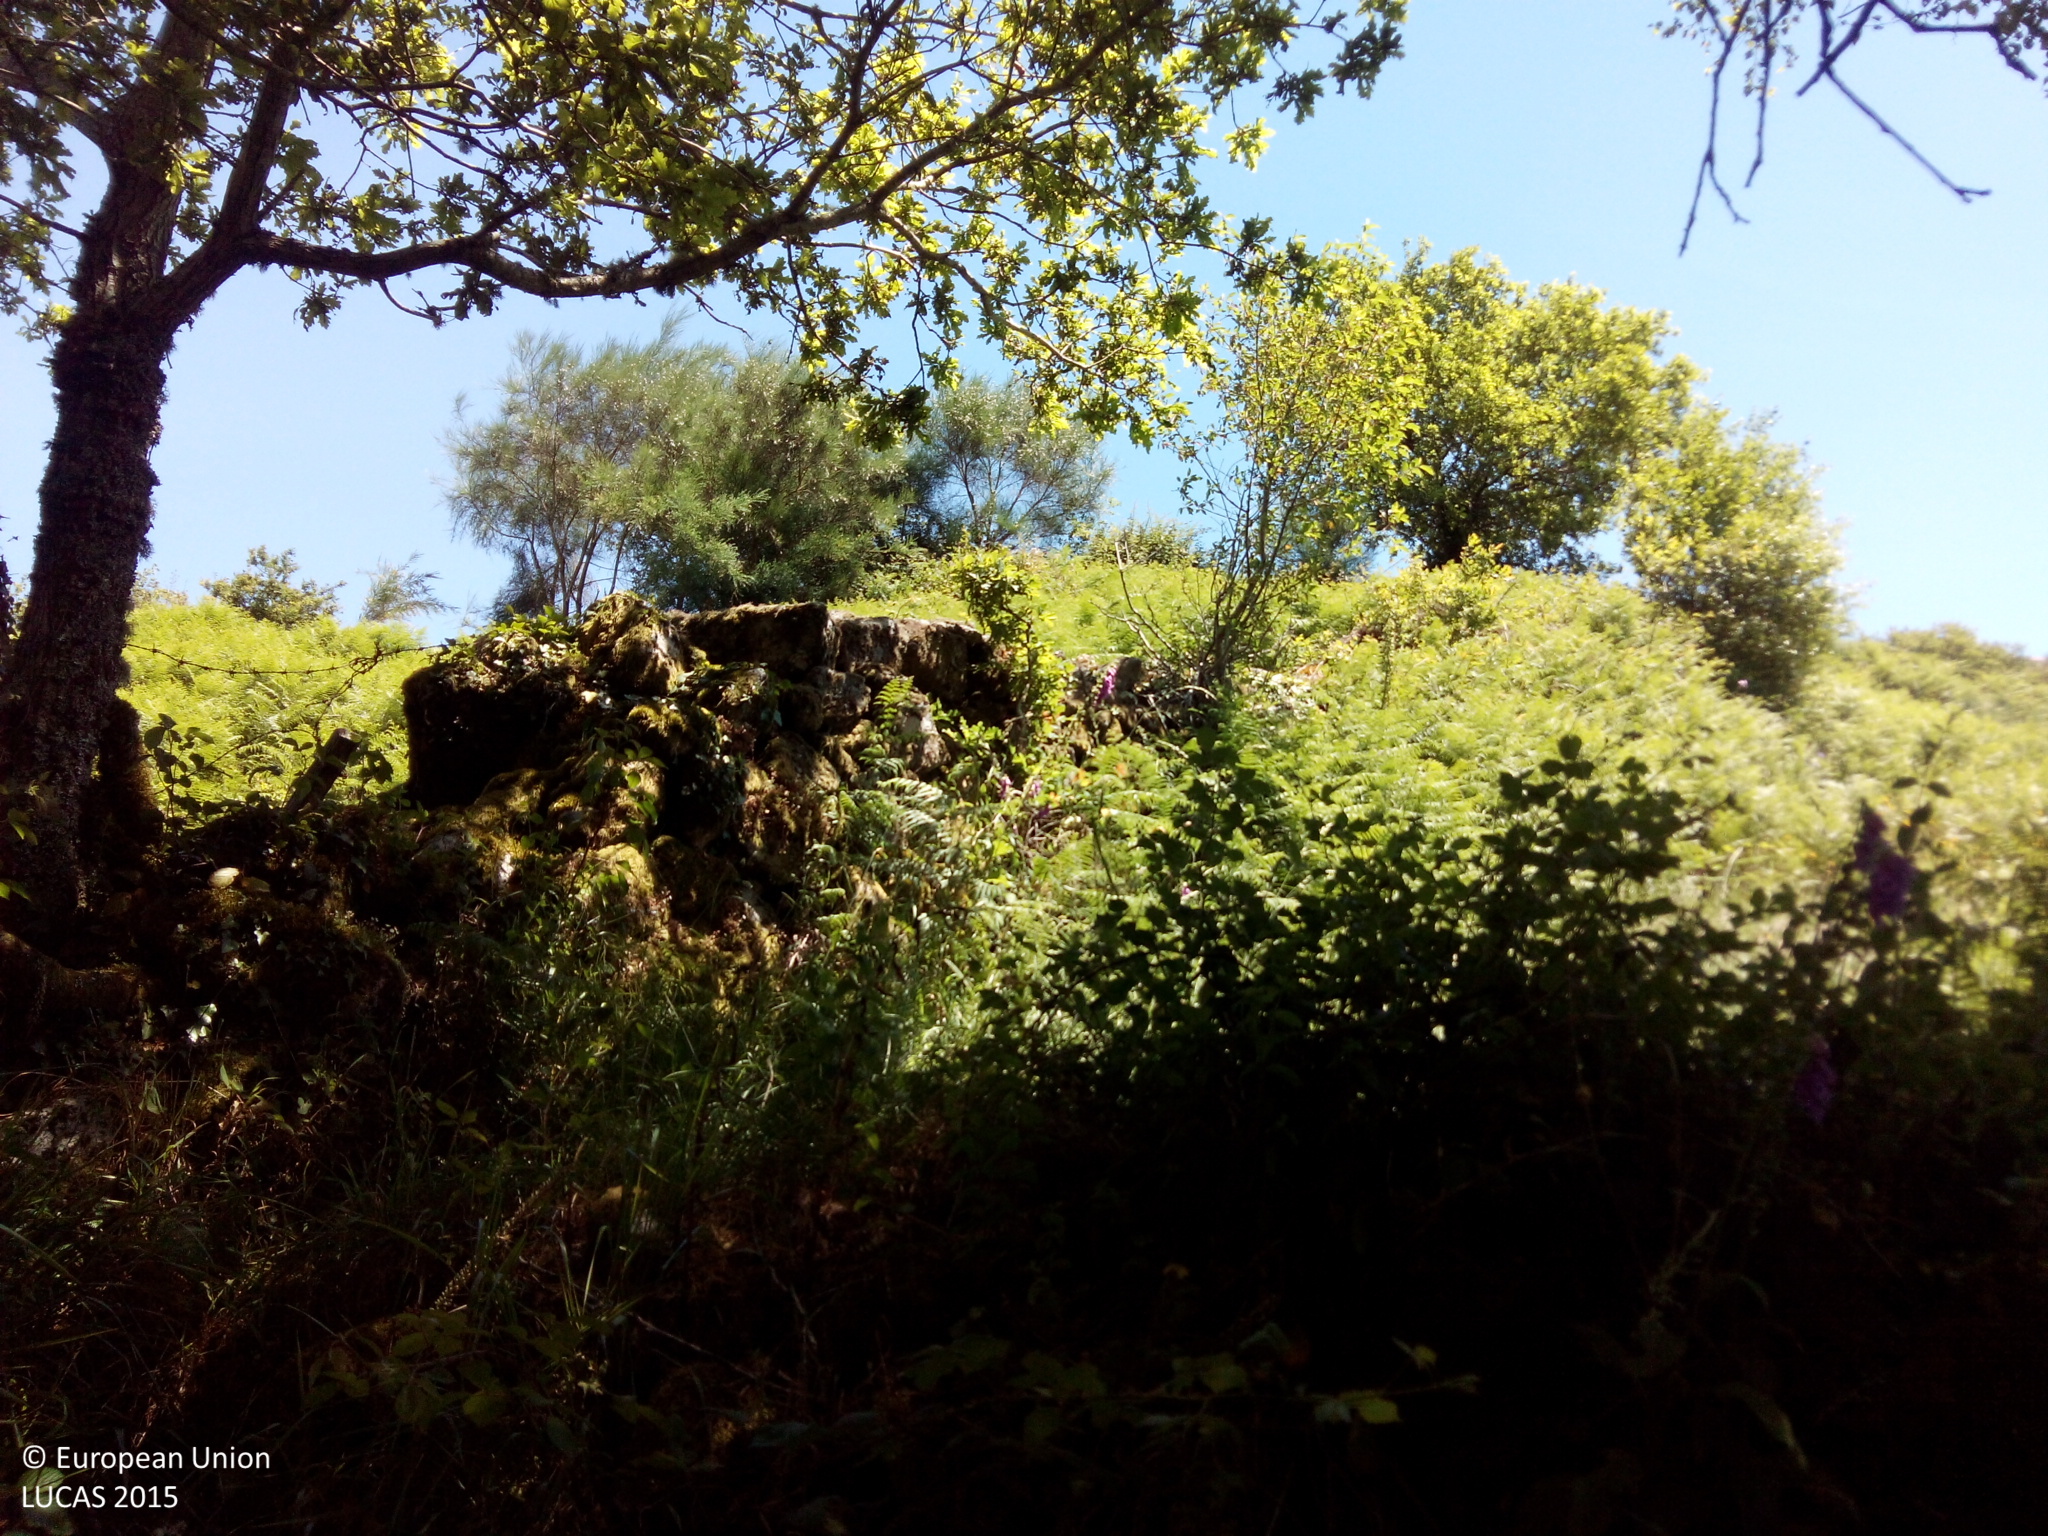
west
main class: Woodland
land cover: Broadleaved woodland
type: acidophilous oak and oak-birch forest
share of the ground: > 75 %
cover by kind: broadleaved forest trees 100 %
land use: Forestry
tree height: > 5 m
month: June
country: ES
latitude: 42.4618
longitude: -8.4221
